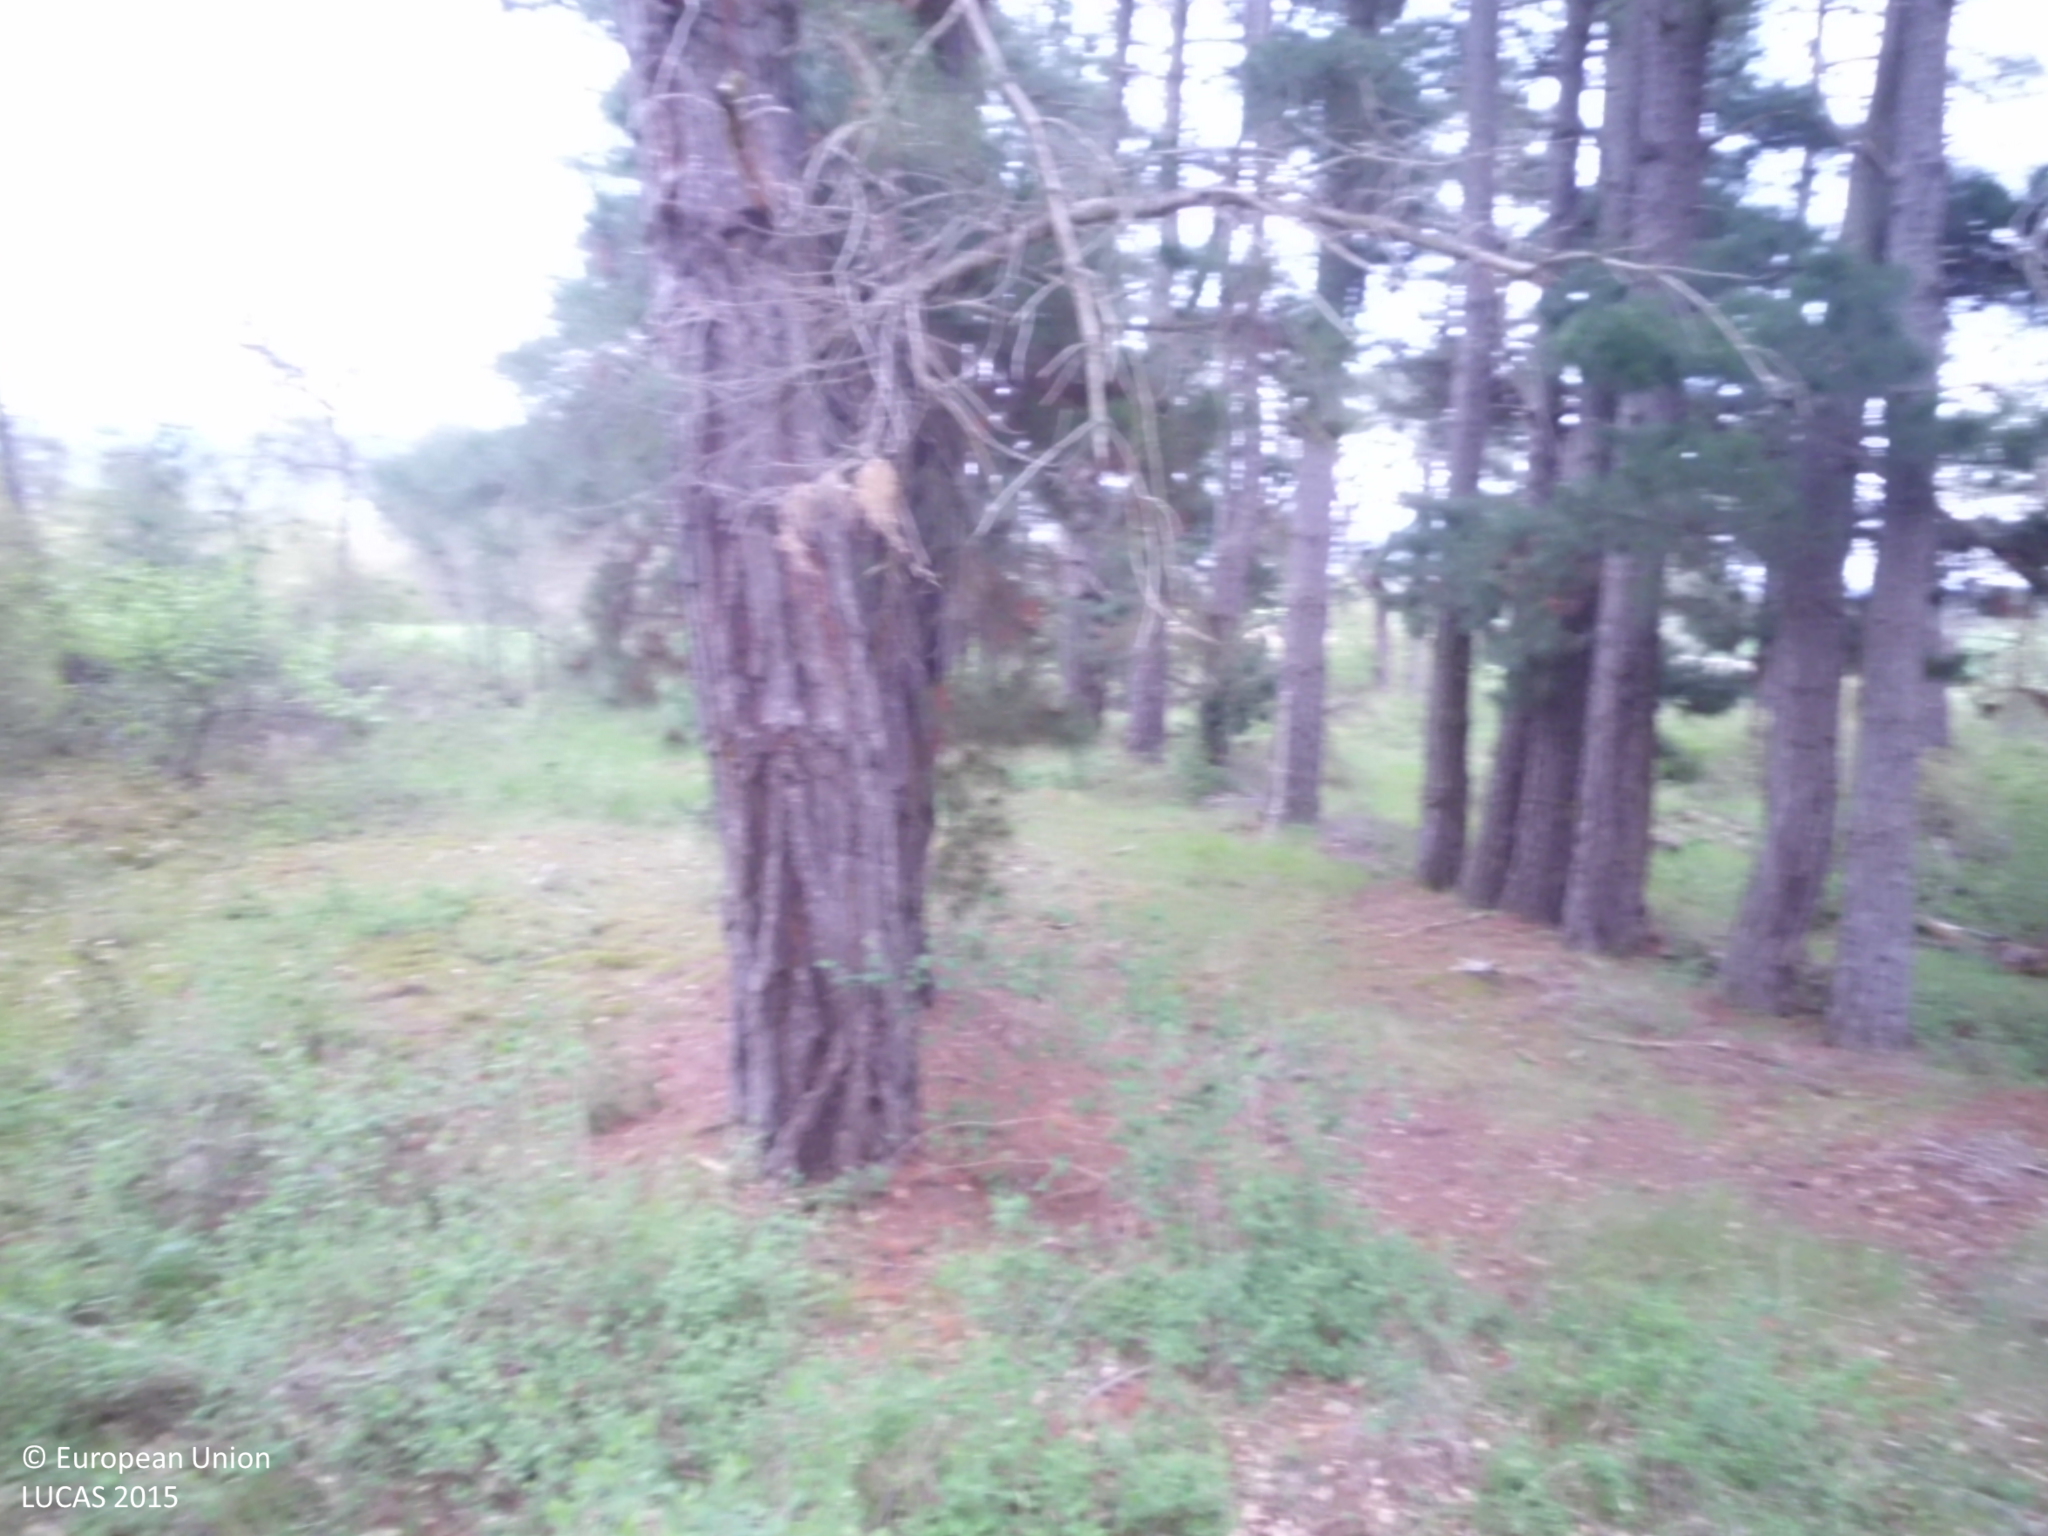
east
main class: Woodland
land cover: Pine dominated mixed woodland
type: coniferous forest of the mediterranean region
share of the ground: > 75 %
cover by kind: coniferous forest trees 50 %, broadleaved forest trees 25 %, shrubs 15 %, herbaceous plants 10 %
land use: Semi-natural and natural areas not in use
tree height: > 5 m
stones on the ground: < 10 %
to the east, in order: Pine dominated mixed woodland; Barley; Fences; Grass margins; Other bare soil
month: April
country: ES
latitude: 42.8041
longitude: -3.3768
